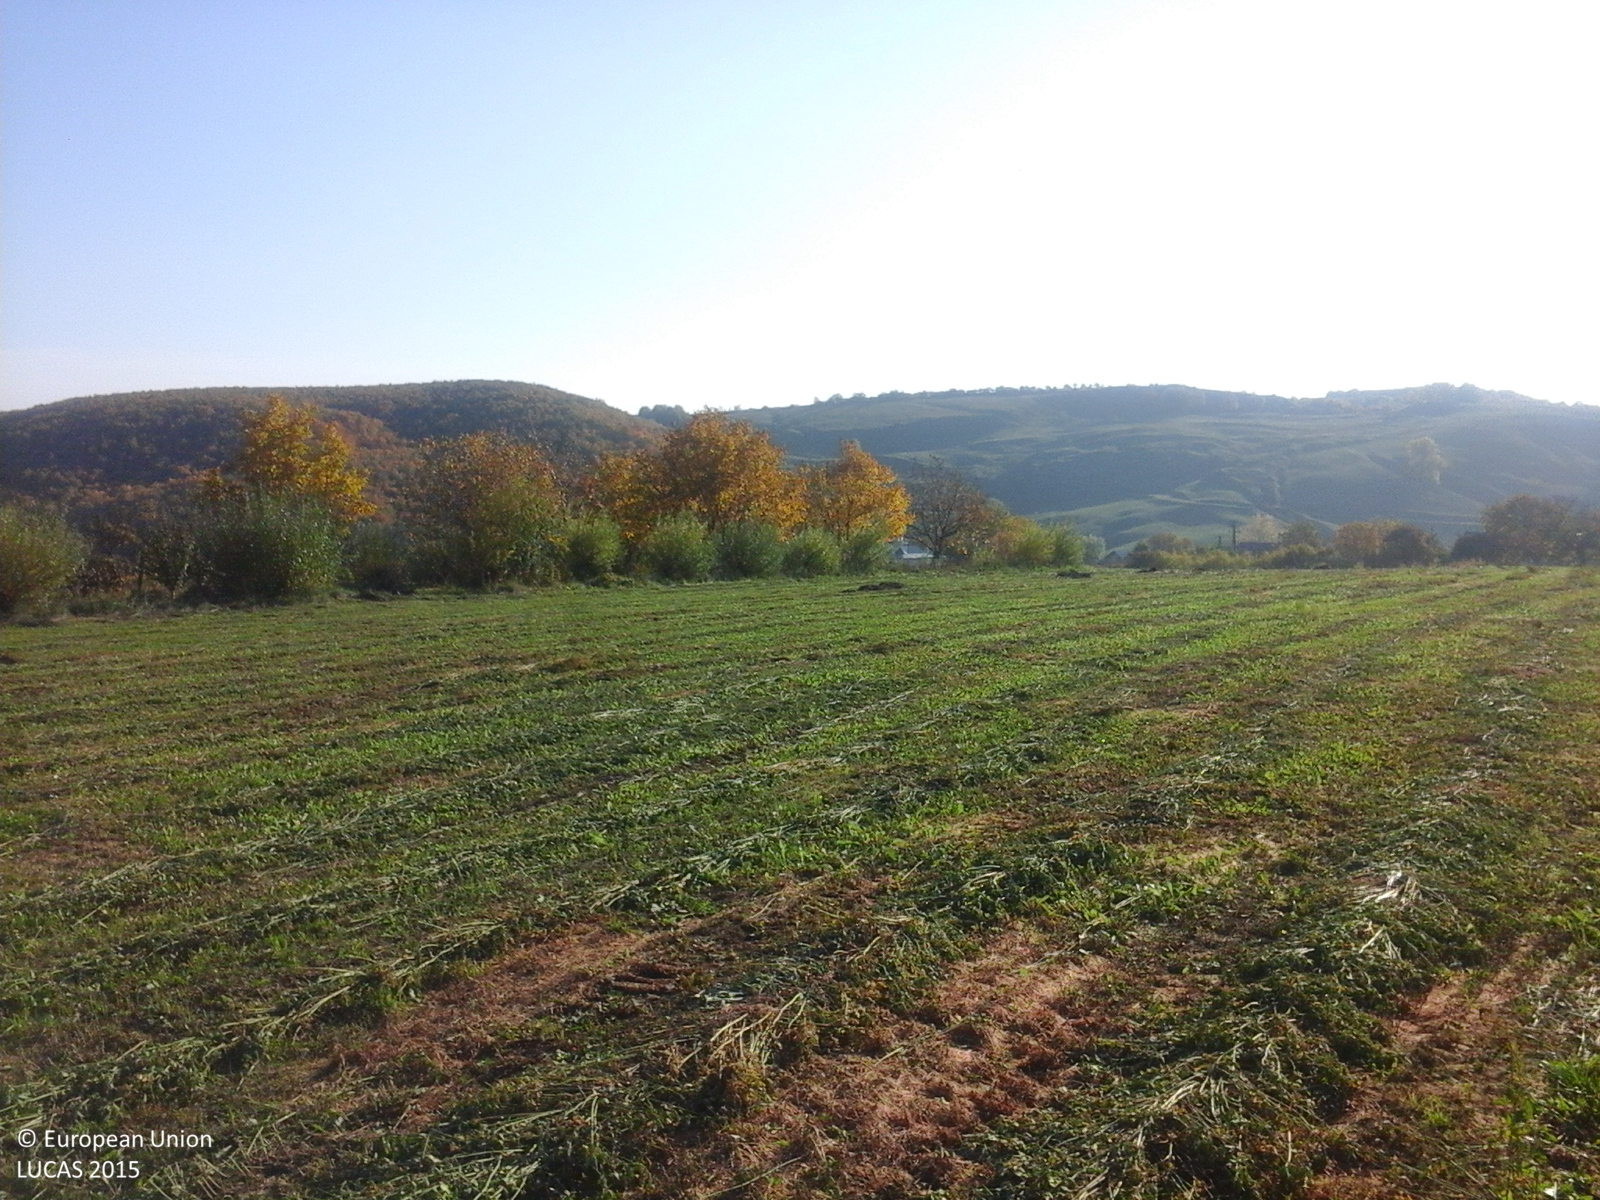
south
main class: Cropland
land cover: Lucerne
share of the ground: > 75 %
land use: Agriculture (excluding fallow land and kitchen gardens)
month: October
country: RO
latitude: 45.9607
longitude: 27.0613
